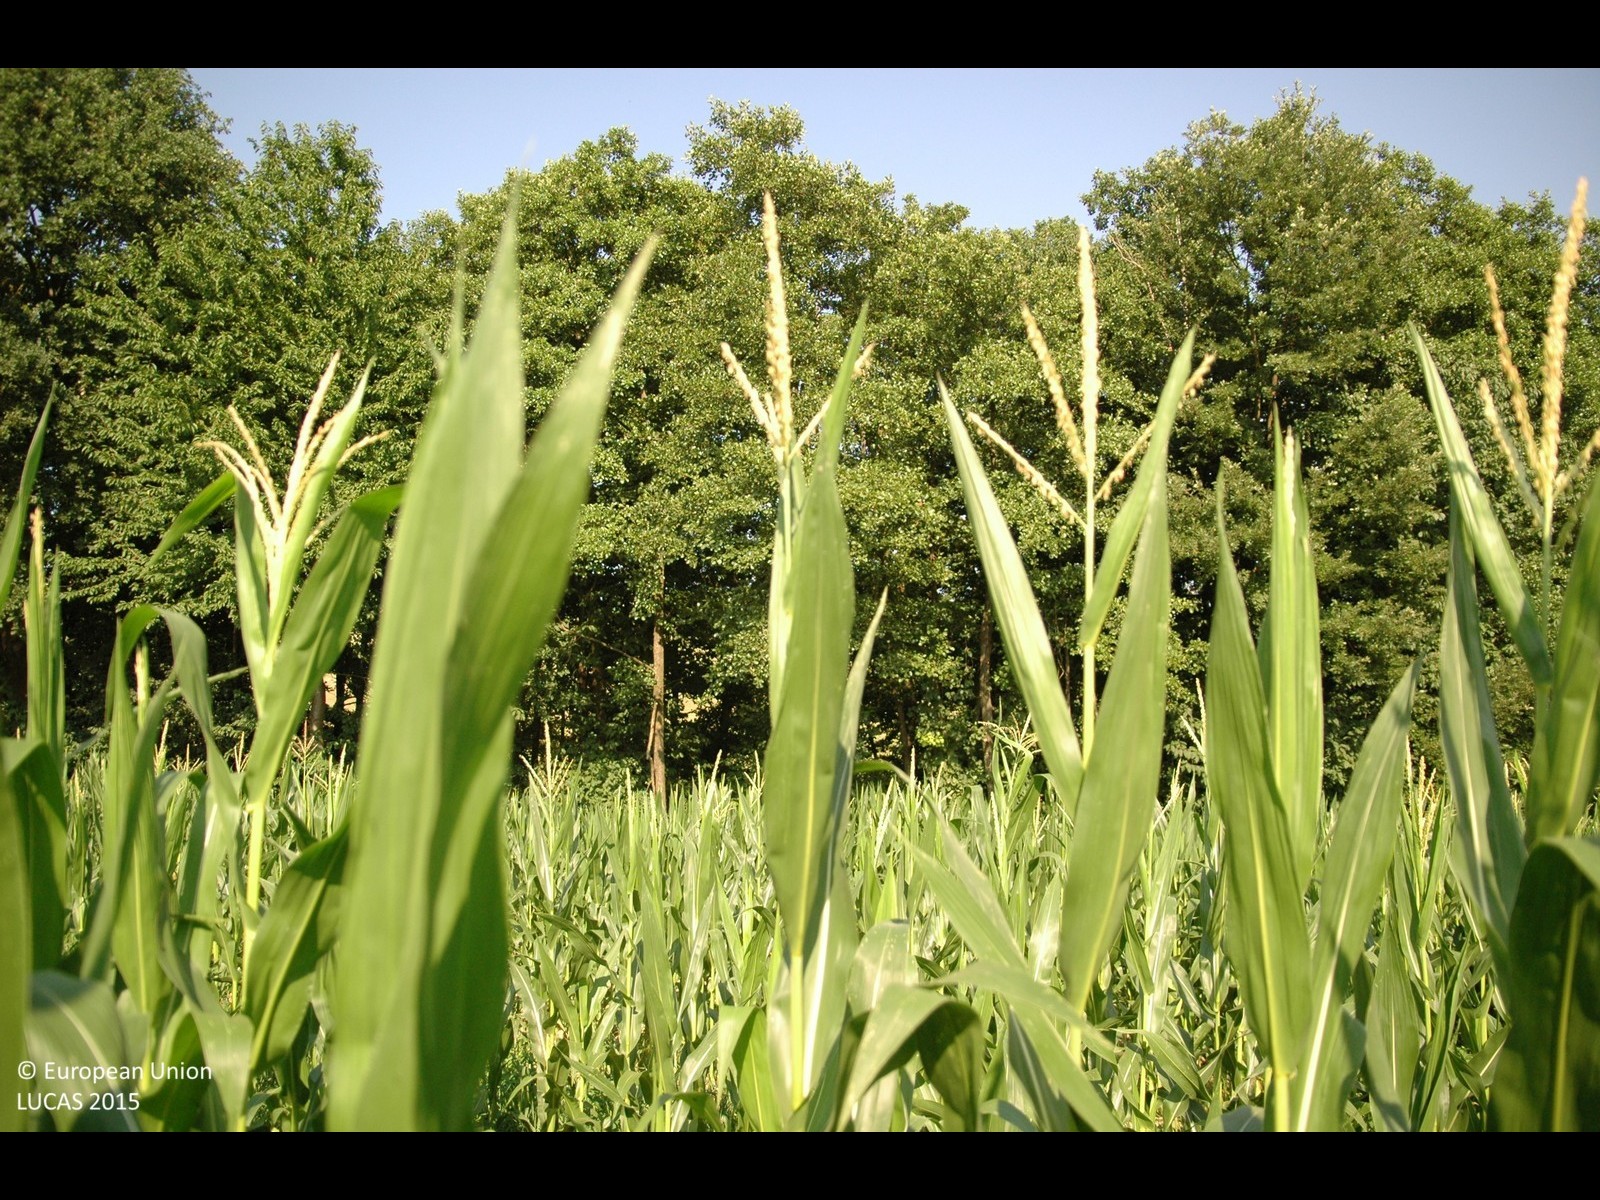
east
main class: Cropland
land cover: Maize
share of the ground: > 75 %
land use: Agriculture (excluding fallow land and kitchen gardens)
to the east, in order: Maize; Broadleaved woodland; Rivers and streams; Broadleaved woodland; Fences; Grassland without tree/shrub cover; Fences; Maize; Tracks; Grassland without tree/shrub cover
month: July
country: HR
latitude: 46.1838
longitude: 16.5948
